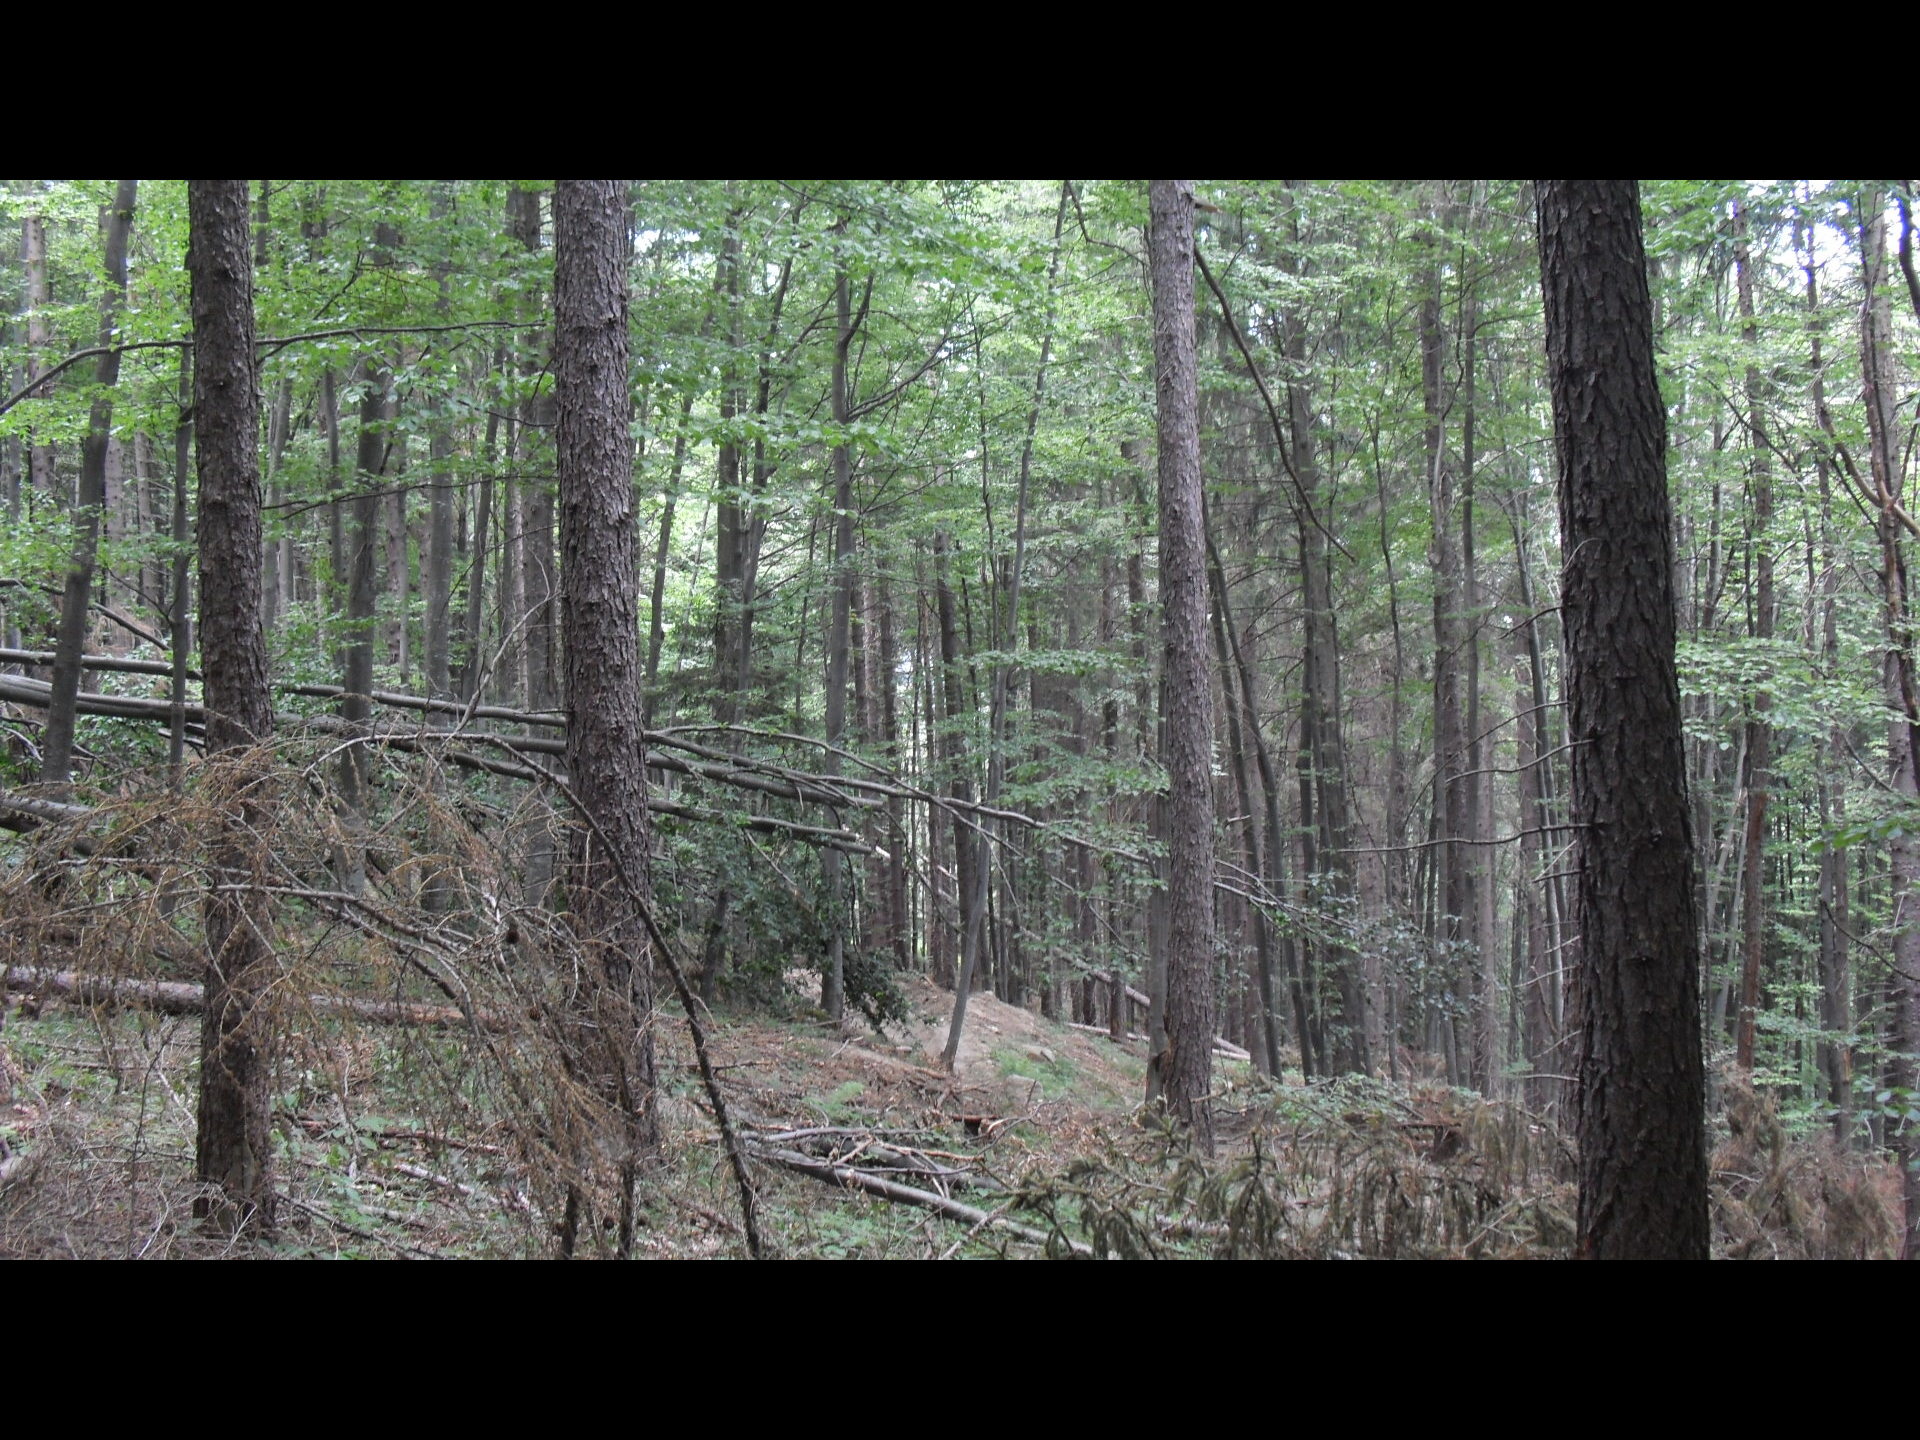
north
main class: Woodland
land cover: Other mixed woodland
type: hemiboreal forest and nemoral coniferous forest and mixed broadleaved-coniferous forest
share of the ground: > 75 %
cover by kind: coniferous forest trees 50 %, broadleaved forest trees 40 %, herbaceous plants 10 %
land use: Forestry
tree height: > 5 m
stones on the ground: < 10 %
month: August
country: BG
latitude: 43.1437
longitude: 23.1554
